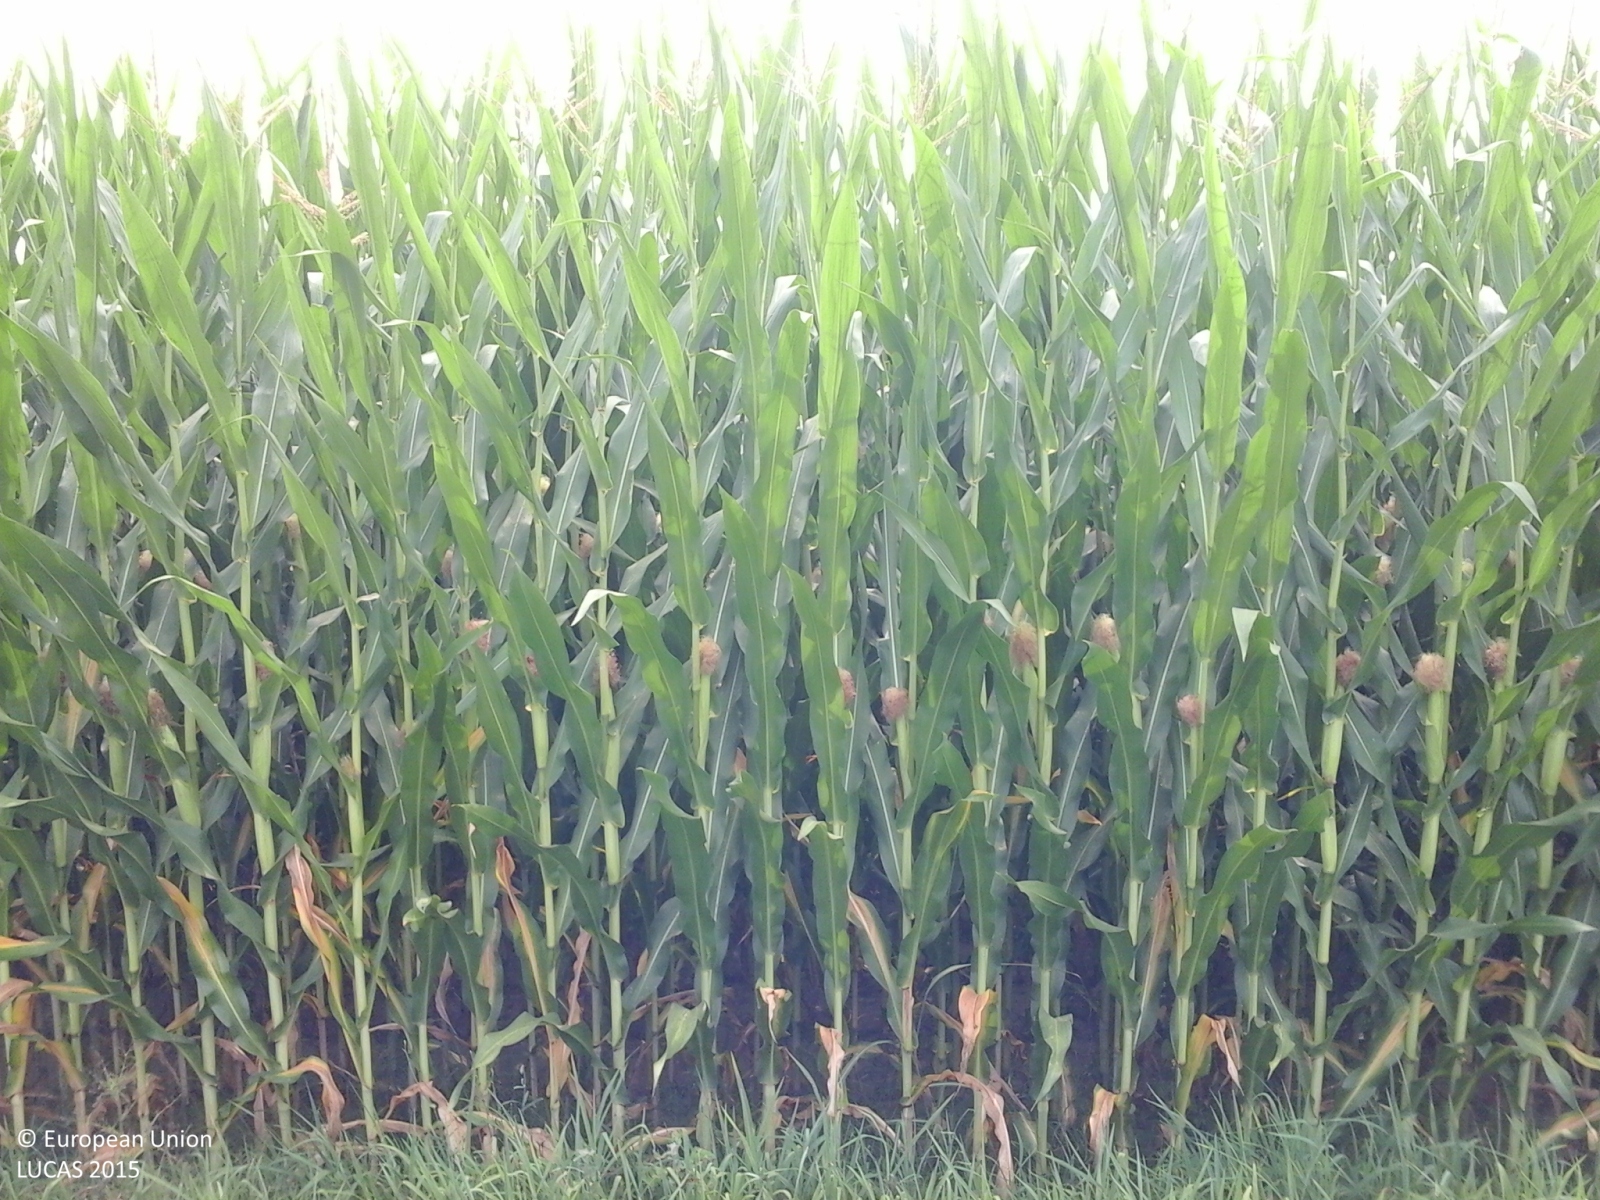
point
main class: Cropland
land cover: Maize
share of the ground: > 75 %
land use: Agriculture (excluding fallow land and kitchen gardens)
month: July
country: IT
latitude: 45.2812
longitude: 8.7911
